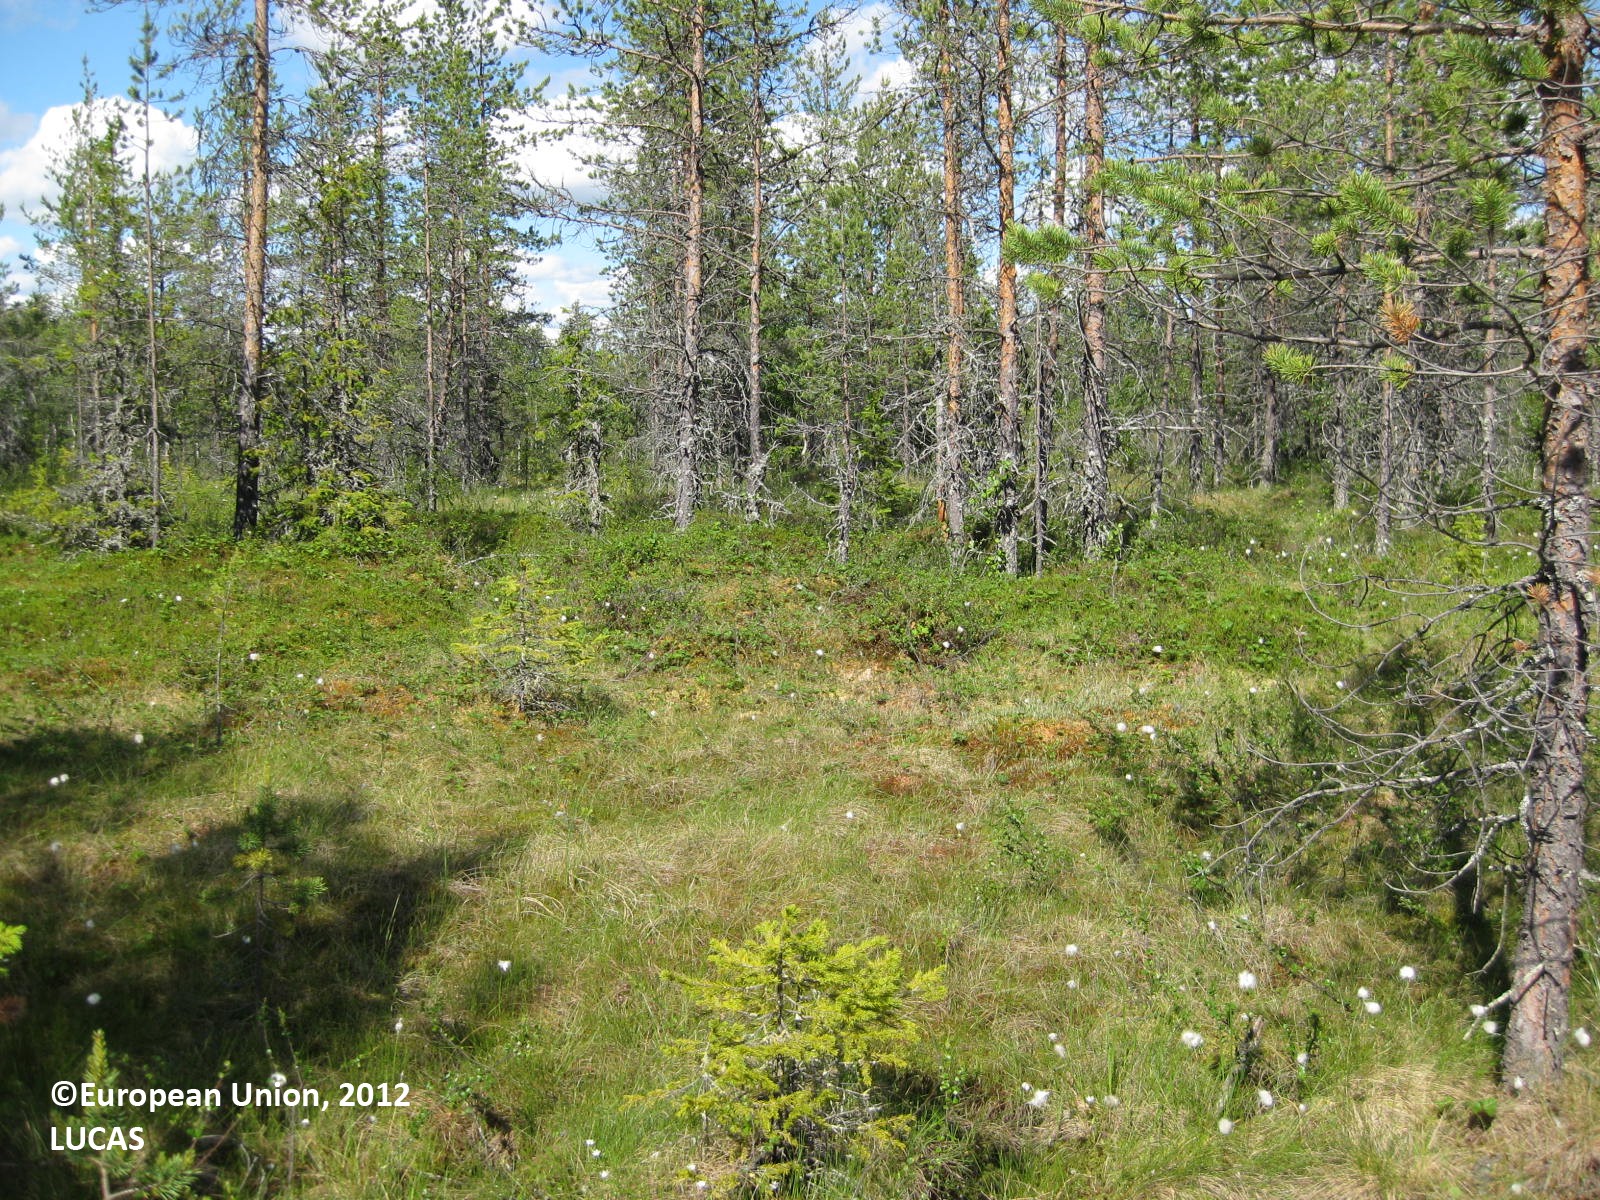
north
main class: Woodland
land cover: Pine dominated coniferous woodland
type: boreal forest
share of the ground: 50 - 75 %
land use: Forestry
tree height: > 5 m
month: July
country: FI
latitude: 65.6085
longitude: 29.4886
